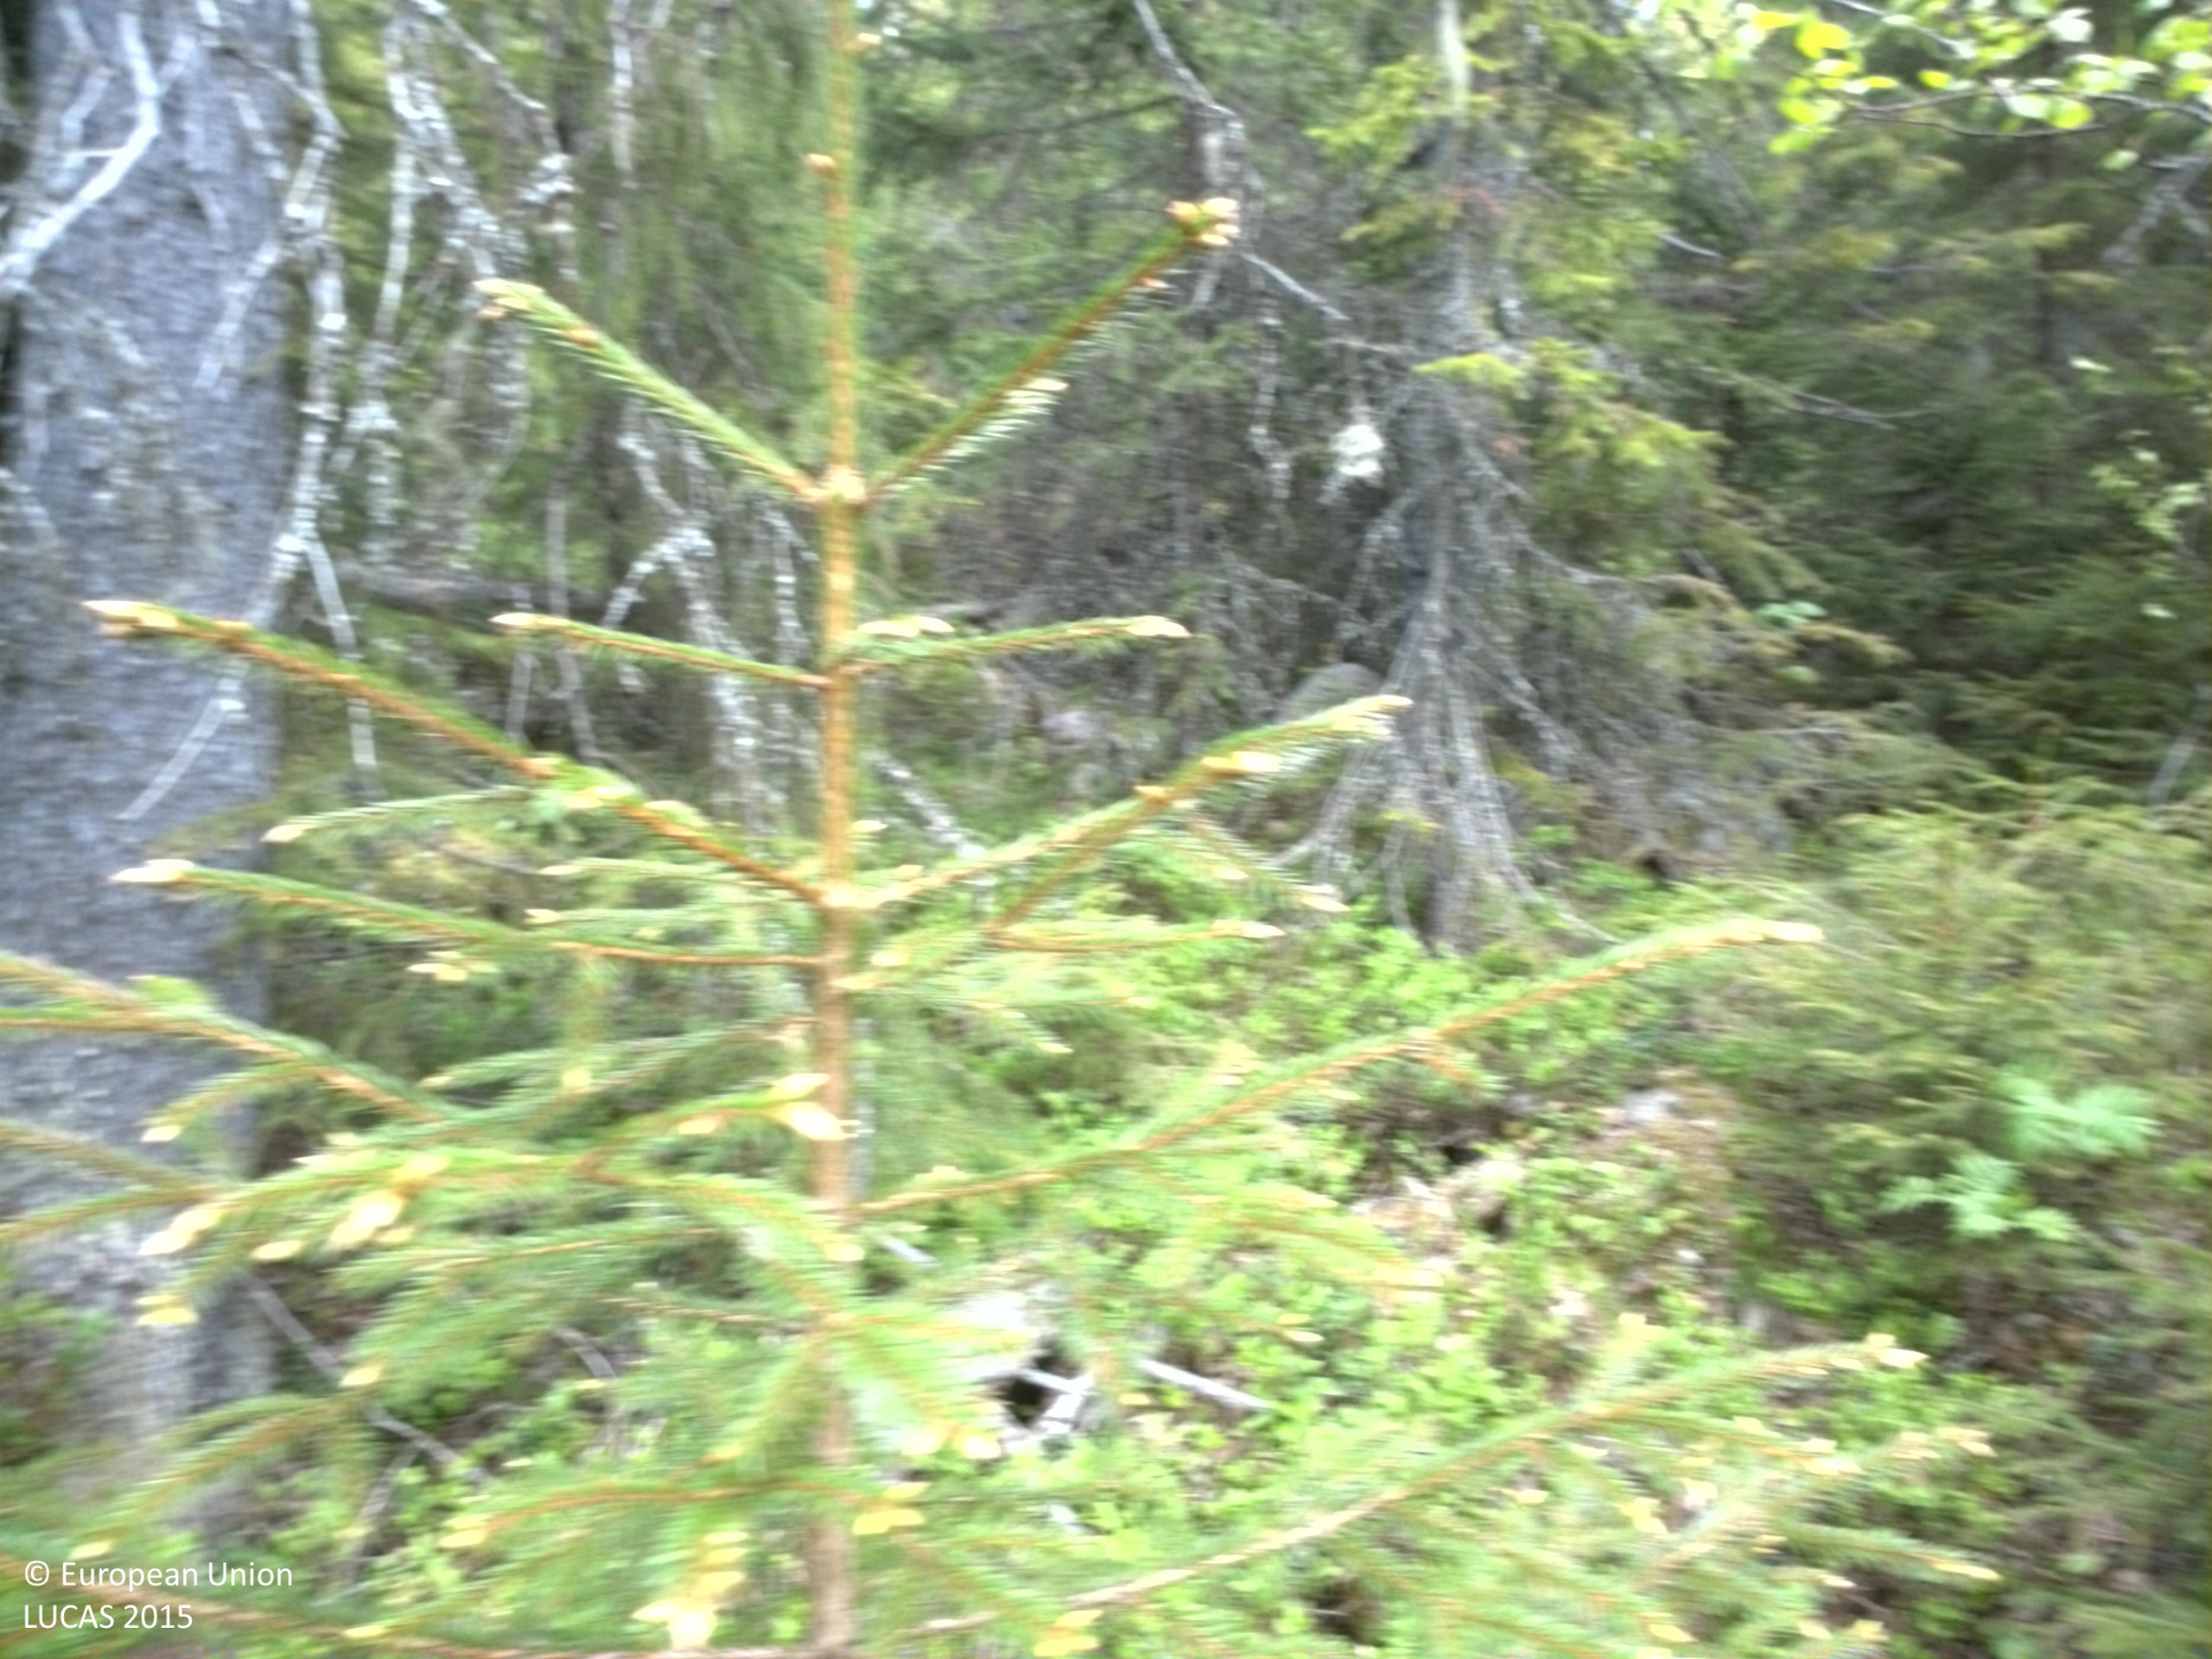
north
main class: Woodland
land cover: Spruce dominated coniferous woodland
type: boreal forest
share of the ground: > 75 %
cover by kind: coniferous forest trees 80 %, shrubs 15 %, herbaceous plants 5 %
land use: Forestry
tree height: > 5 m
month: June
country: SE
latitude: 62.9592
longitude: 17.3313
